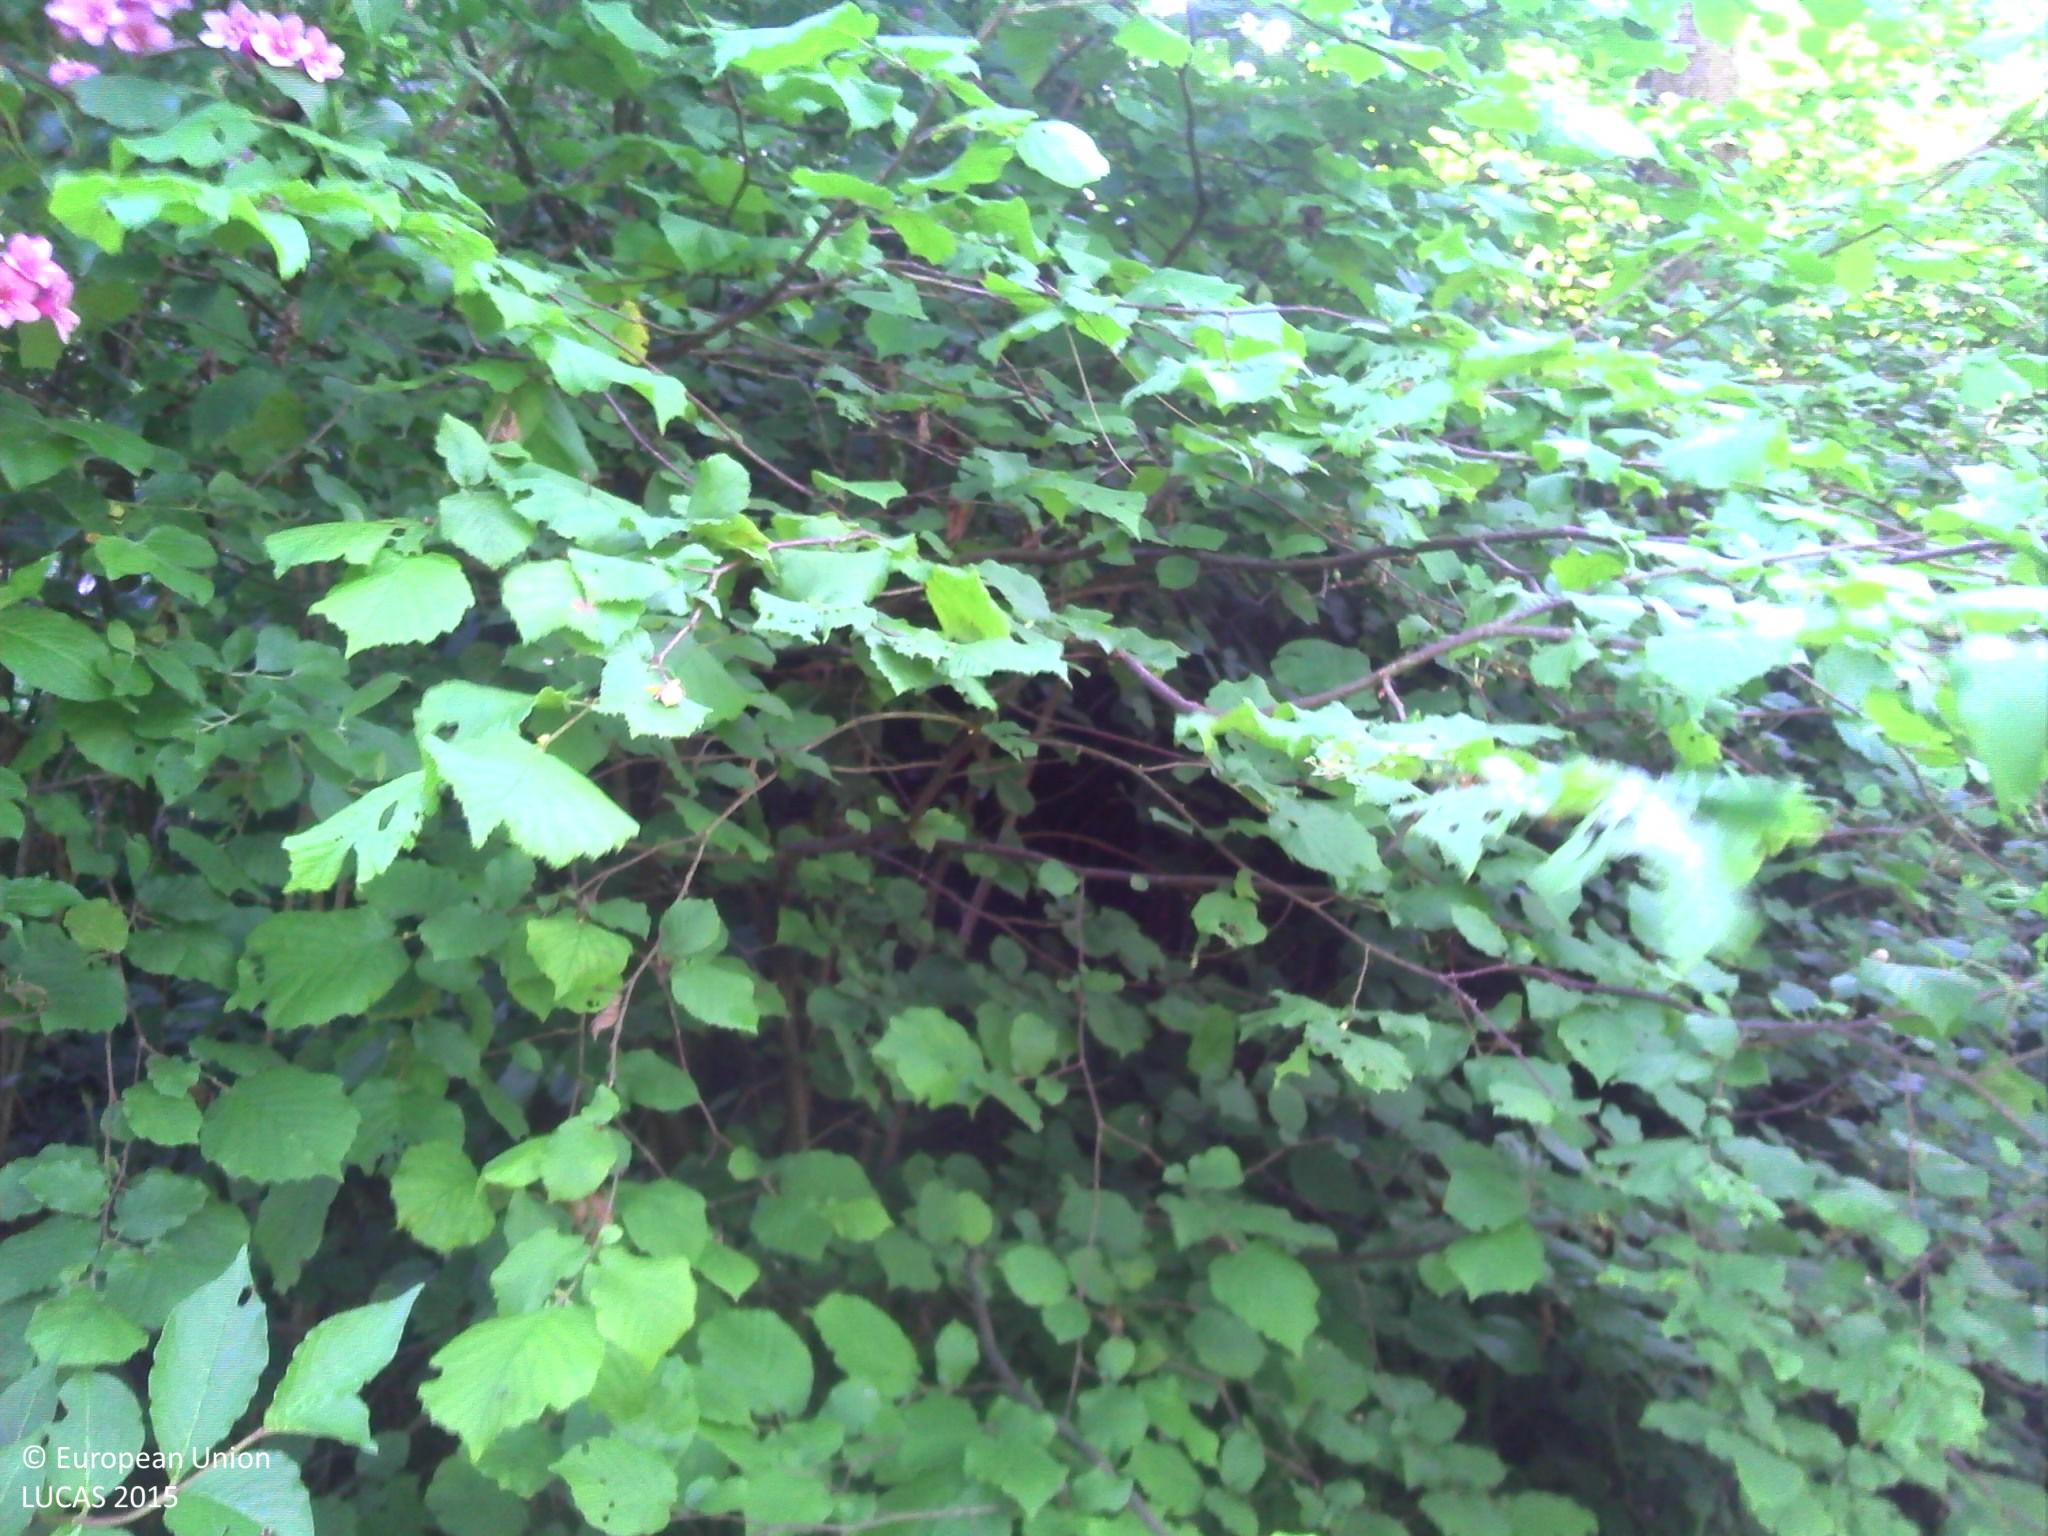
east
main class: Woodland
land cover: Broadleaved woodland
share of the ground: 50 - 75 %
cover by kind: broadleaved forest trees 60 %, herbaceous plants 25 %, coniferous forest trees 15 %
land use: Residential
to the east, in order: Broadleaved woodland; Artificial constructions in urban areas; Broadleaved woodland; Grassland without tree/shrub cover; Fences; Grassland without tree/shrub cover; Fences; Shrubland without tree cover; Tracks; Managed hedges
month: June
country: BE
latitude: 50.0532
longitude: 4.5351
